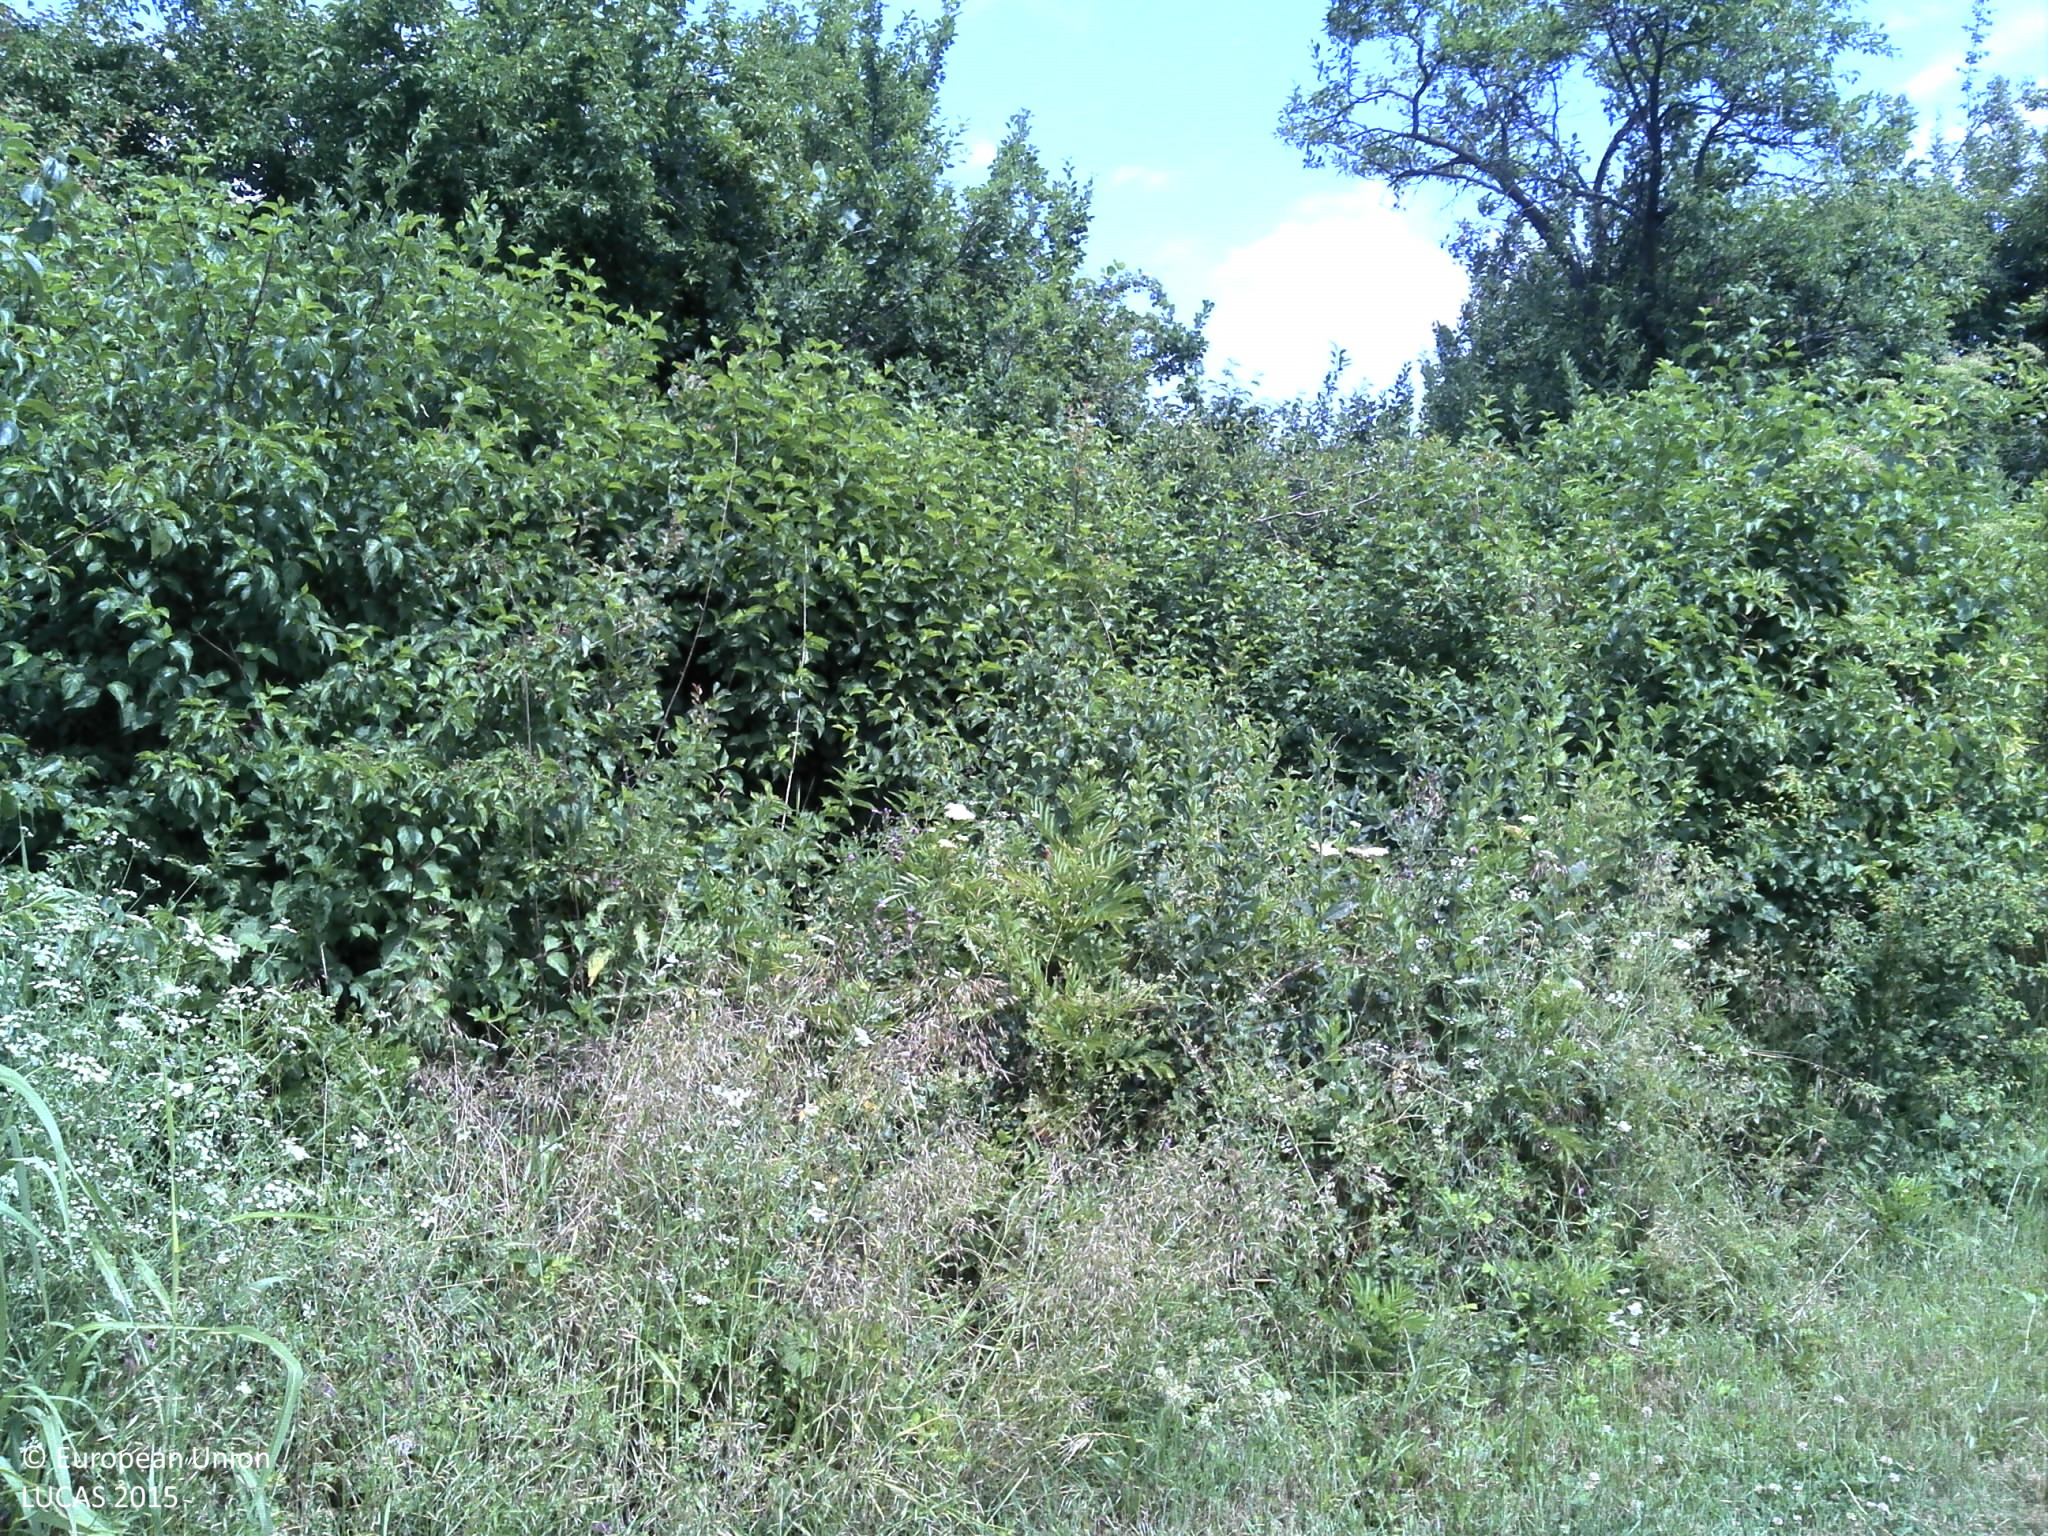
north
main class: Grassland
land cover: Grassland without tree/shrub cover
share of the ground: > 75 %
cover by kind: herbaceous plants 100 %
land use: Agriculture (excluding fallow land and kitchen gardens)
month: June
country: HR
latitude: 45.5080
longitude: 18.4667
